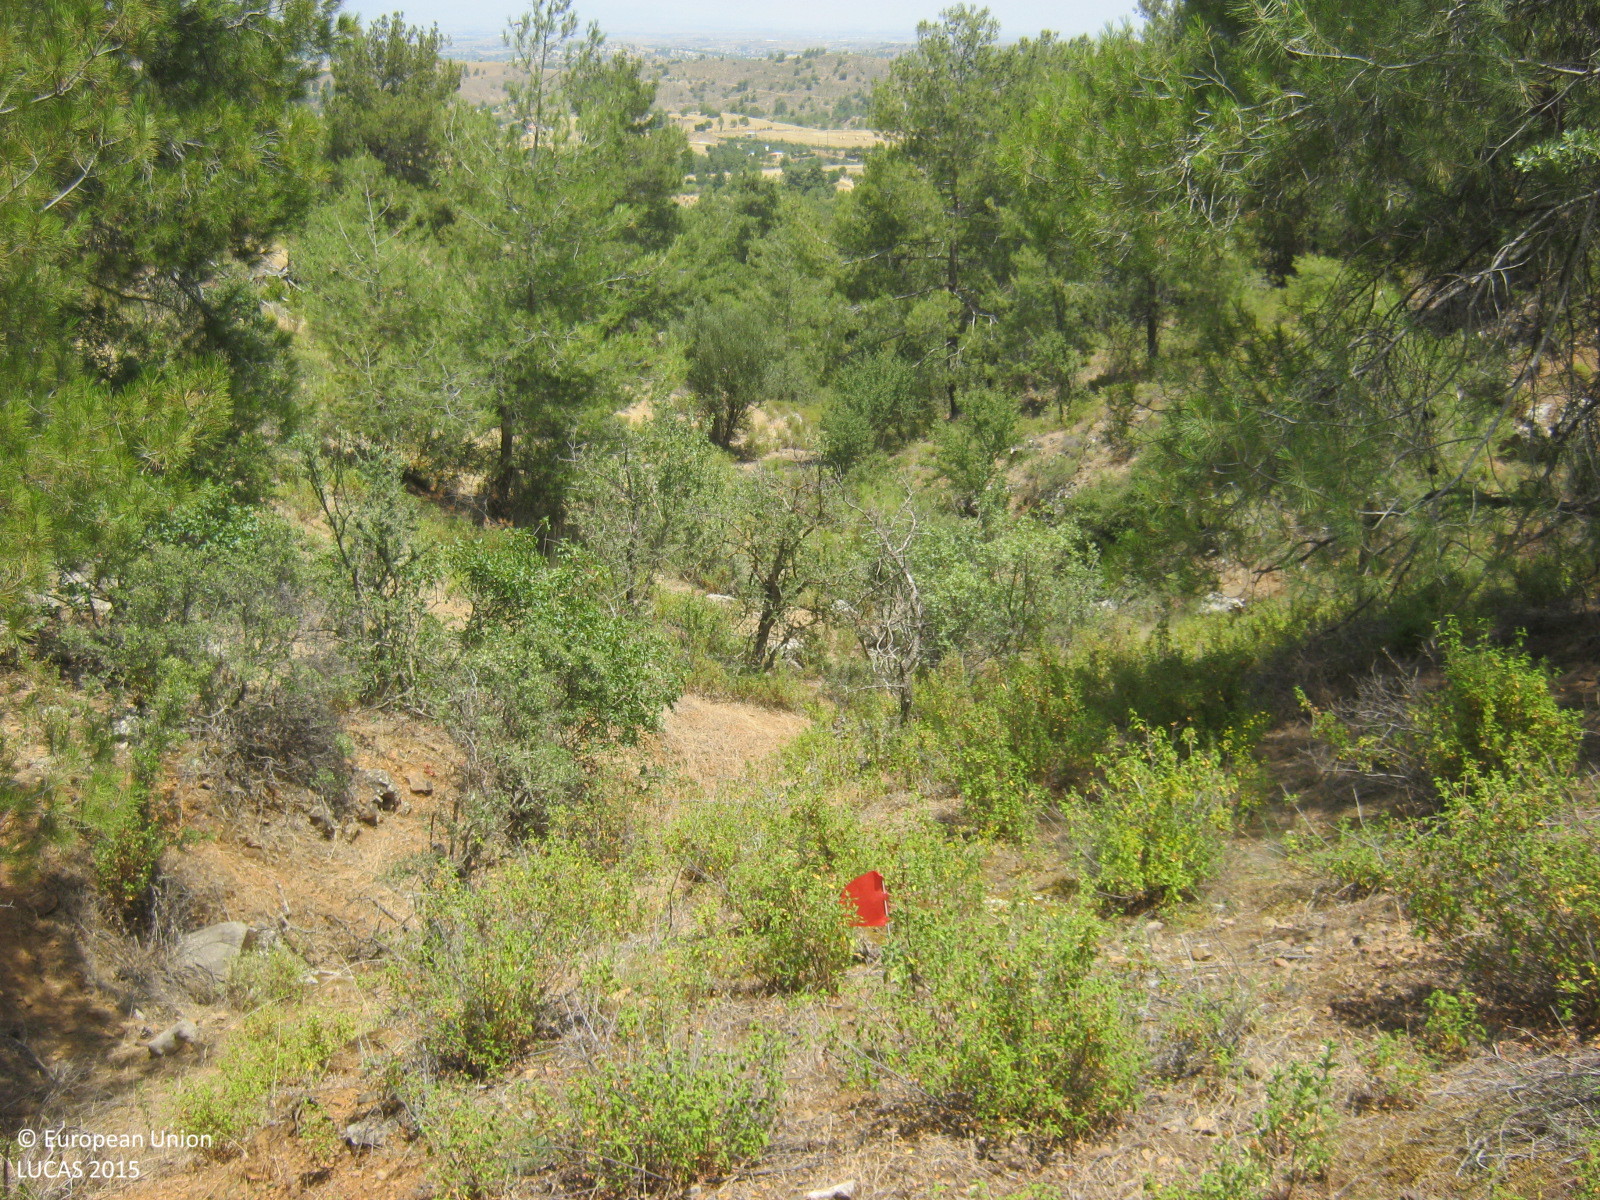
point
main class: Woodland
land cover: Pine dominated coniferous woodland
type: coniferous forest of the mediterranean region
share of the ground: 50 - 75 %
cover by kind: coniferous forest trees 60 %, shrubs 20 %, broadleaved forest trees 10 %, unconsolidated bare surface 10 %
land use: Forestry
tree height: > 5 m
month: June
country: CY
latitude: 34.9925
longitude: 33.1767
